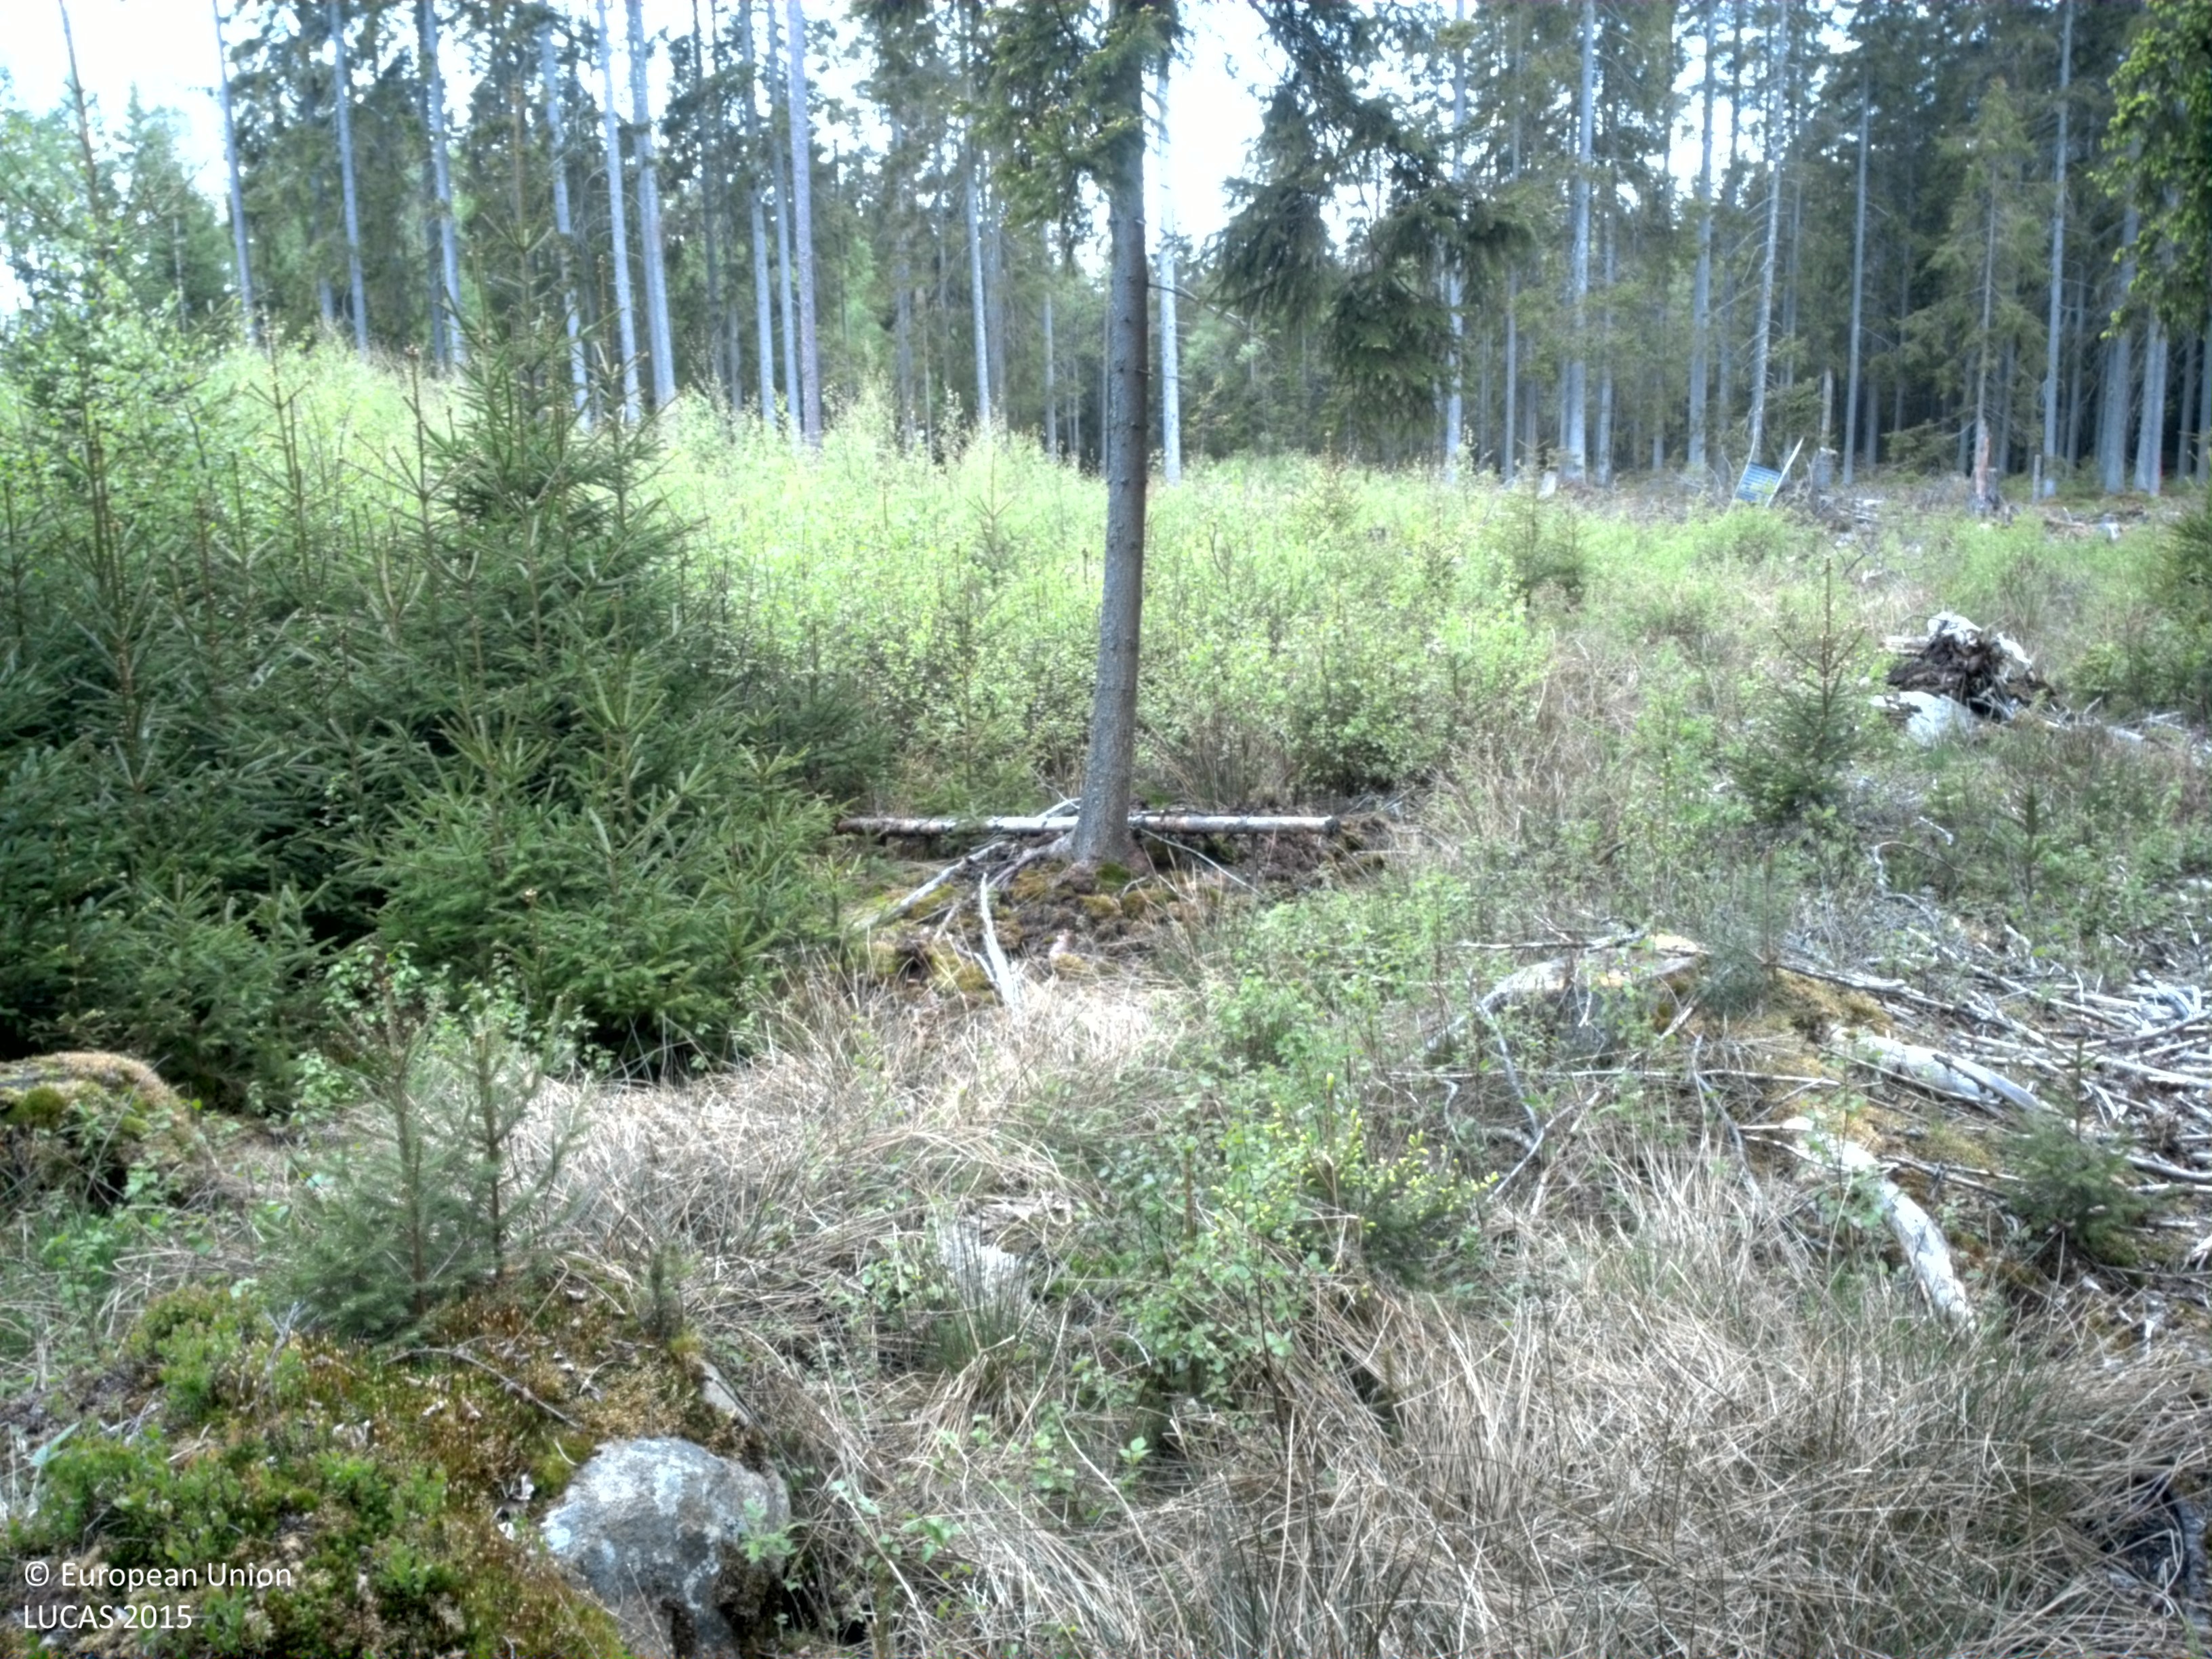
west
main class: Woodland
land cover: Spruce dominated mixed woodland
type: boreal forest
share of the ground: 25 - 50 %
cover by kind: coniferous forest trees 30 %, herbaceous plants 20 %, unconsolidated bare surface 15 %, broadleaved forest trees 10 %, shrubs 10 %, lichens and mosses 10 %, consolidated bare surface 5 %
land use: Forestry
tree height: > 5 m
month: May
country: SE
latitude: 56.6563
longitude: 15.2672
